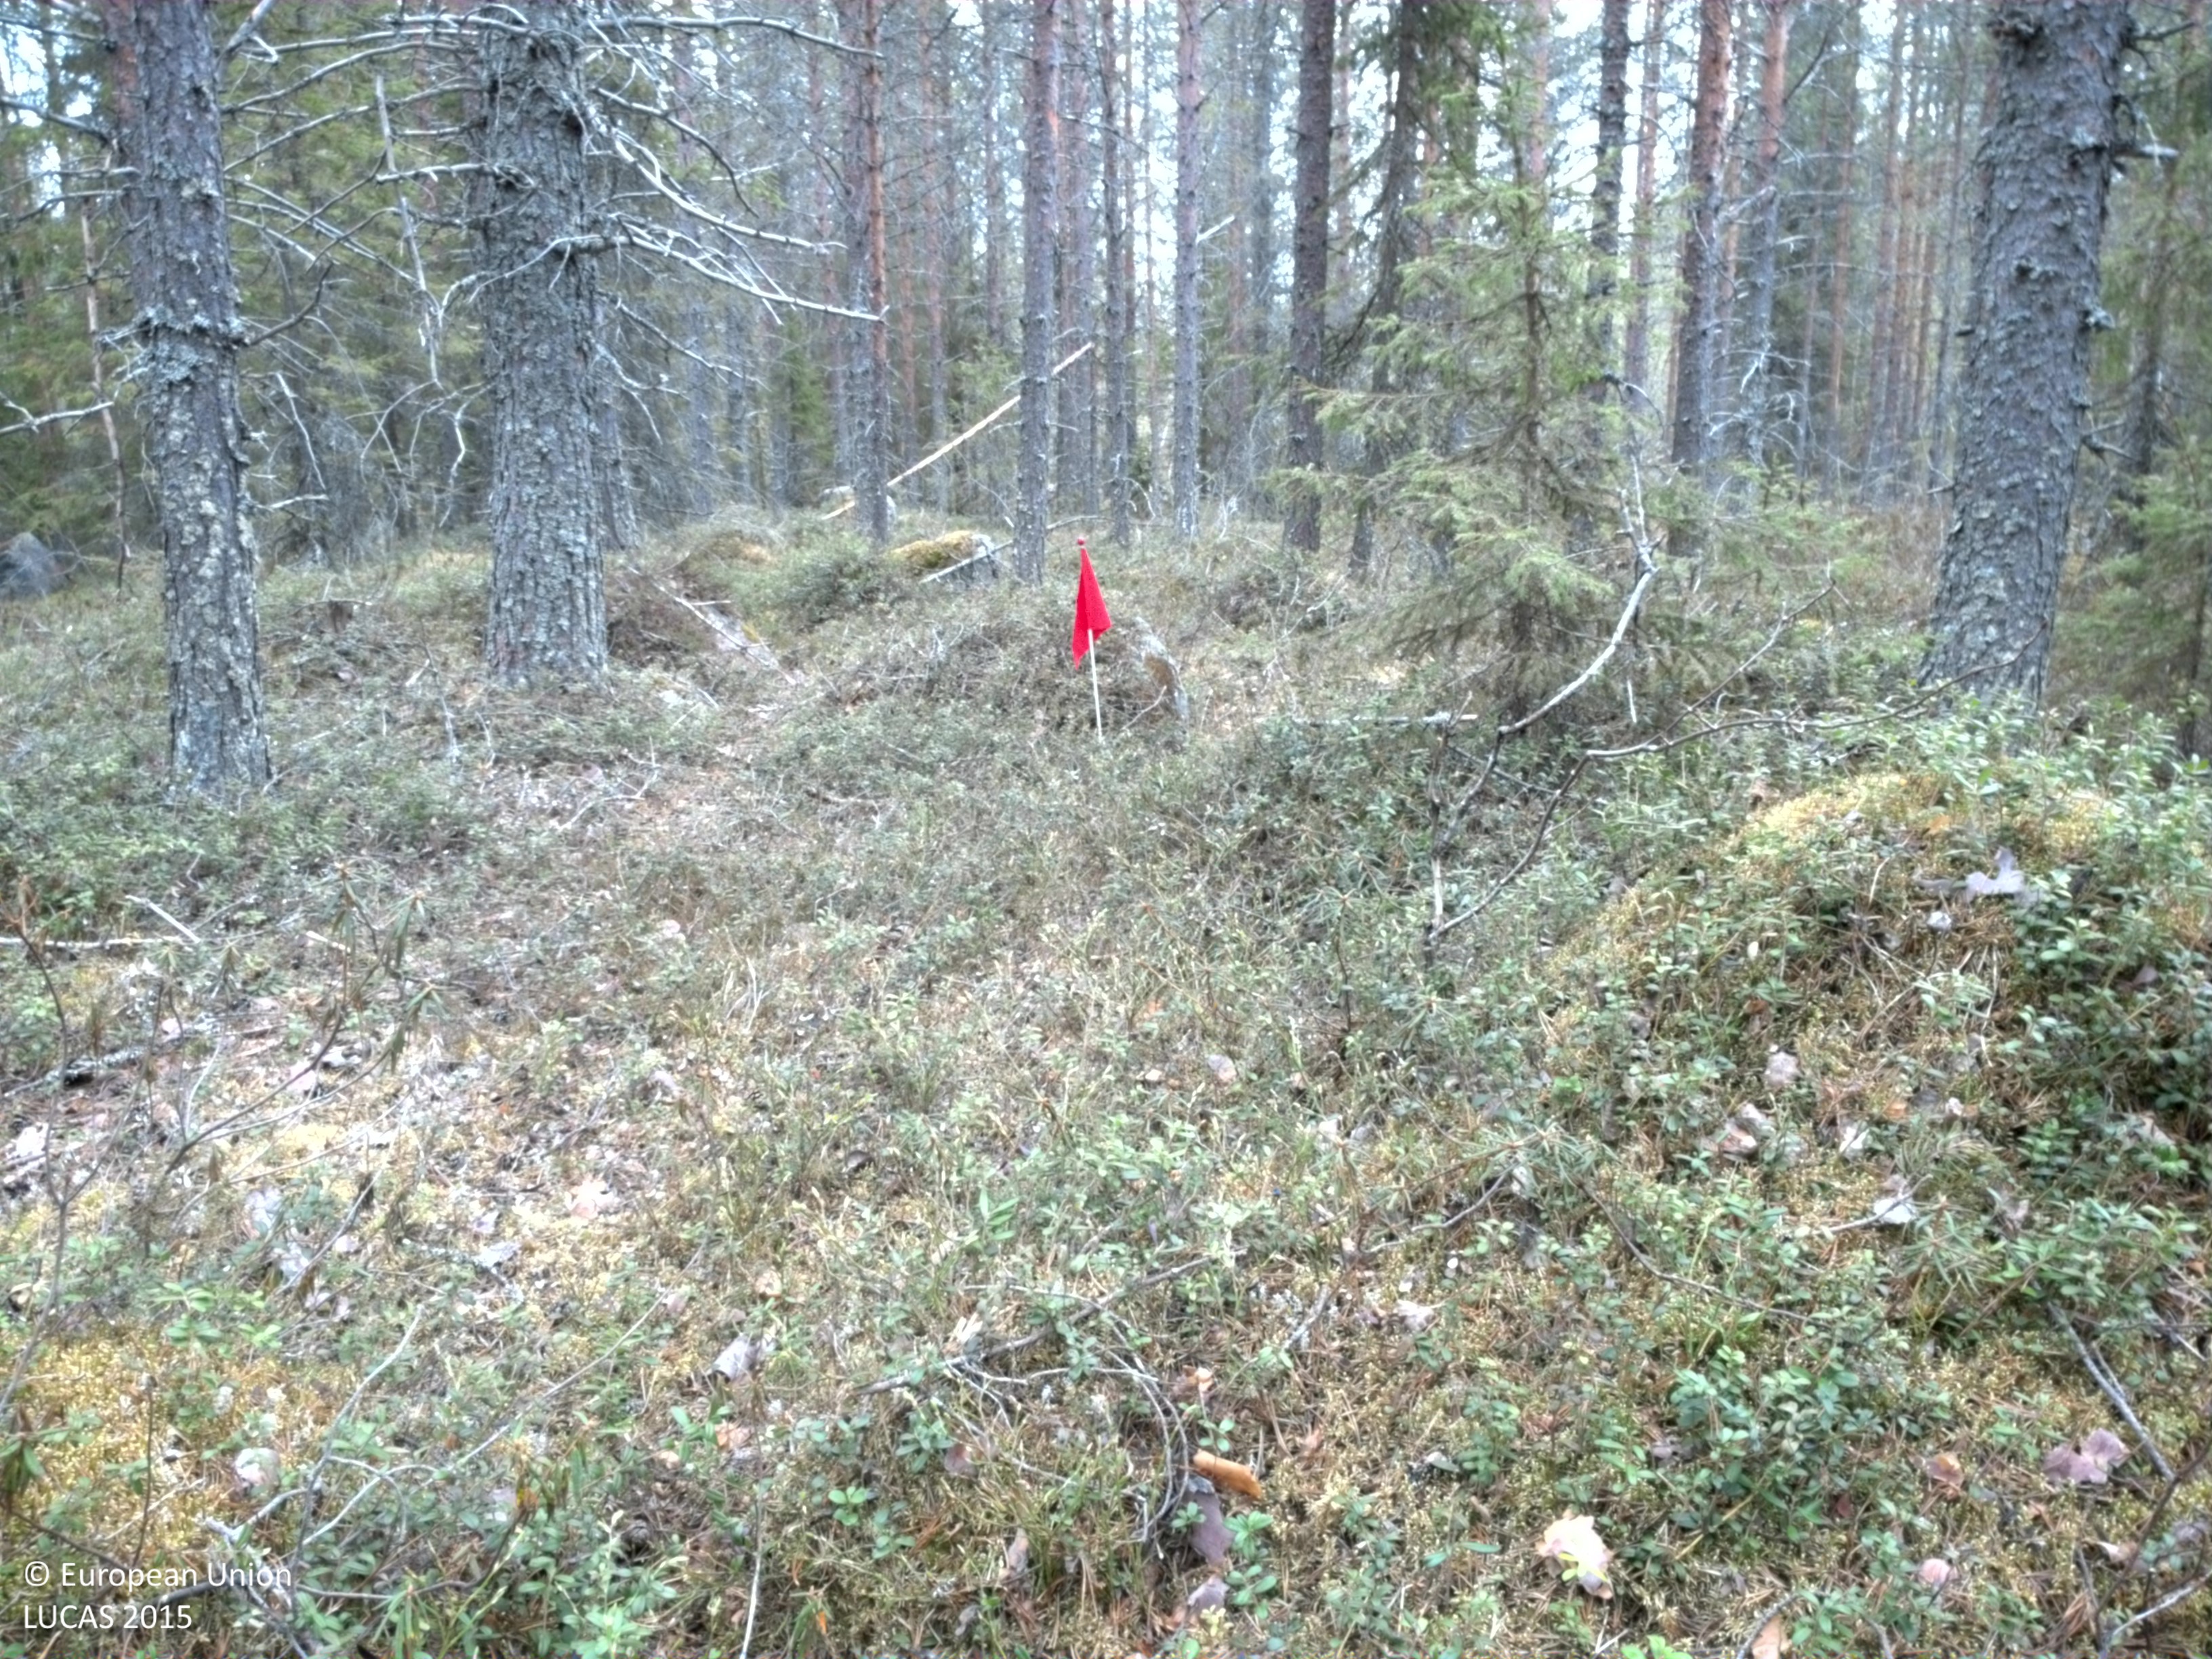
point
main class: Woodland
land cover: Pine dominated coniferous woodland
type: boreal forest
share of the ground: 50 - 75 %
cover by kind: coniferous forest trees 60 %, shrubs 35 %, lichens and mosses 5 %
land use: Forestry
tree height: > 5 m
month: May
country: SE
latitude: 66.0034
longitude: 23.3203
